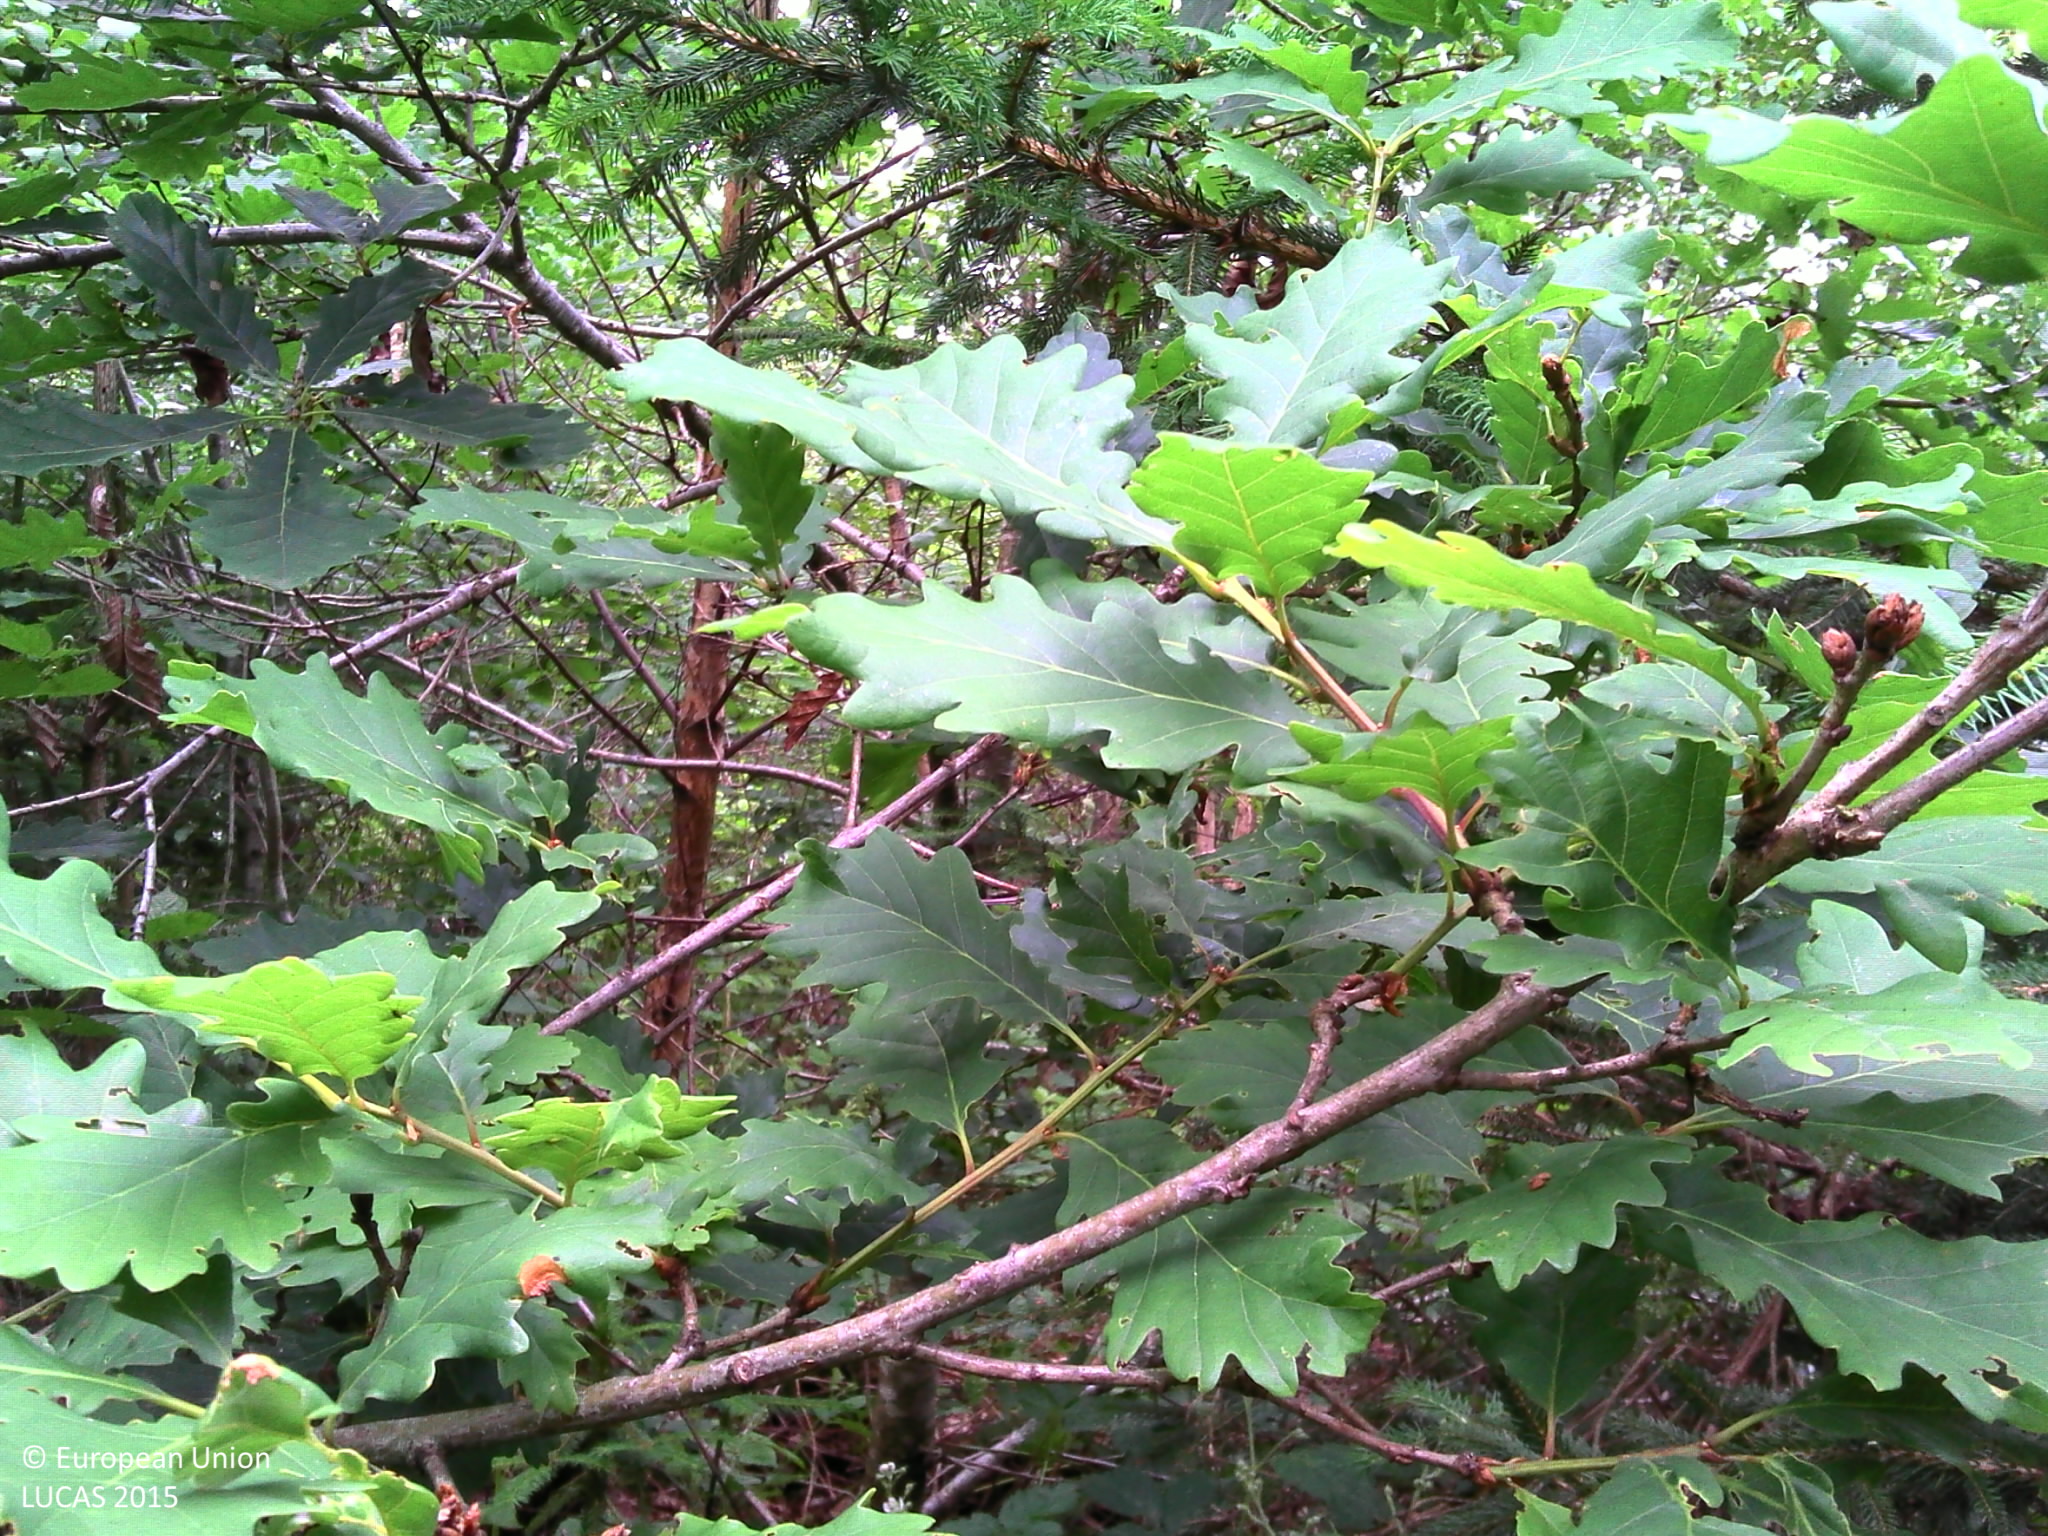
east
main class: Woodland
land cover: Spruce dominated coniferous woodland
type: alpine coniferous forest
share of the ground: > 75 %
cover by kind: coniferous forest trees 100 %
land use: Forestry
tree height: > 5 m
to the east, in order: Spruce dominated coniferous woodland; Broadleaved woodland; Grass margins; Paved roads, cycling and walking lanes; Grass margins; Spruce dominated coniferous woodland; Tracks; Spruce dominated coniferous woodland
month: June
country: BE
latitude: 49.8739
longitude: 5.3645
